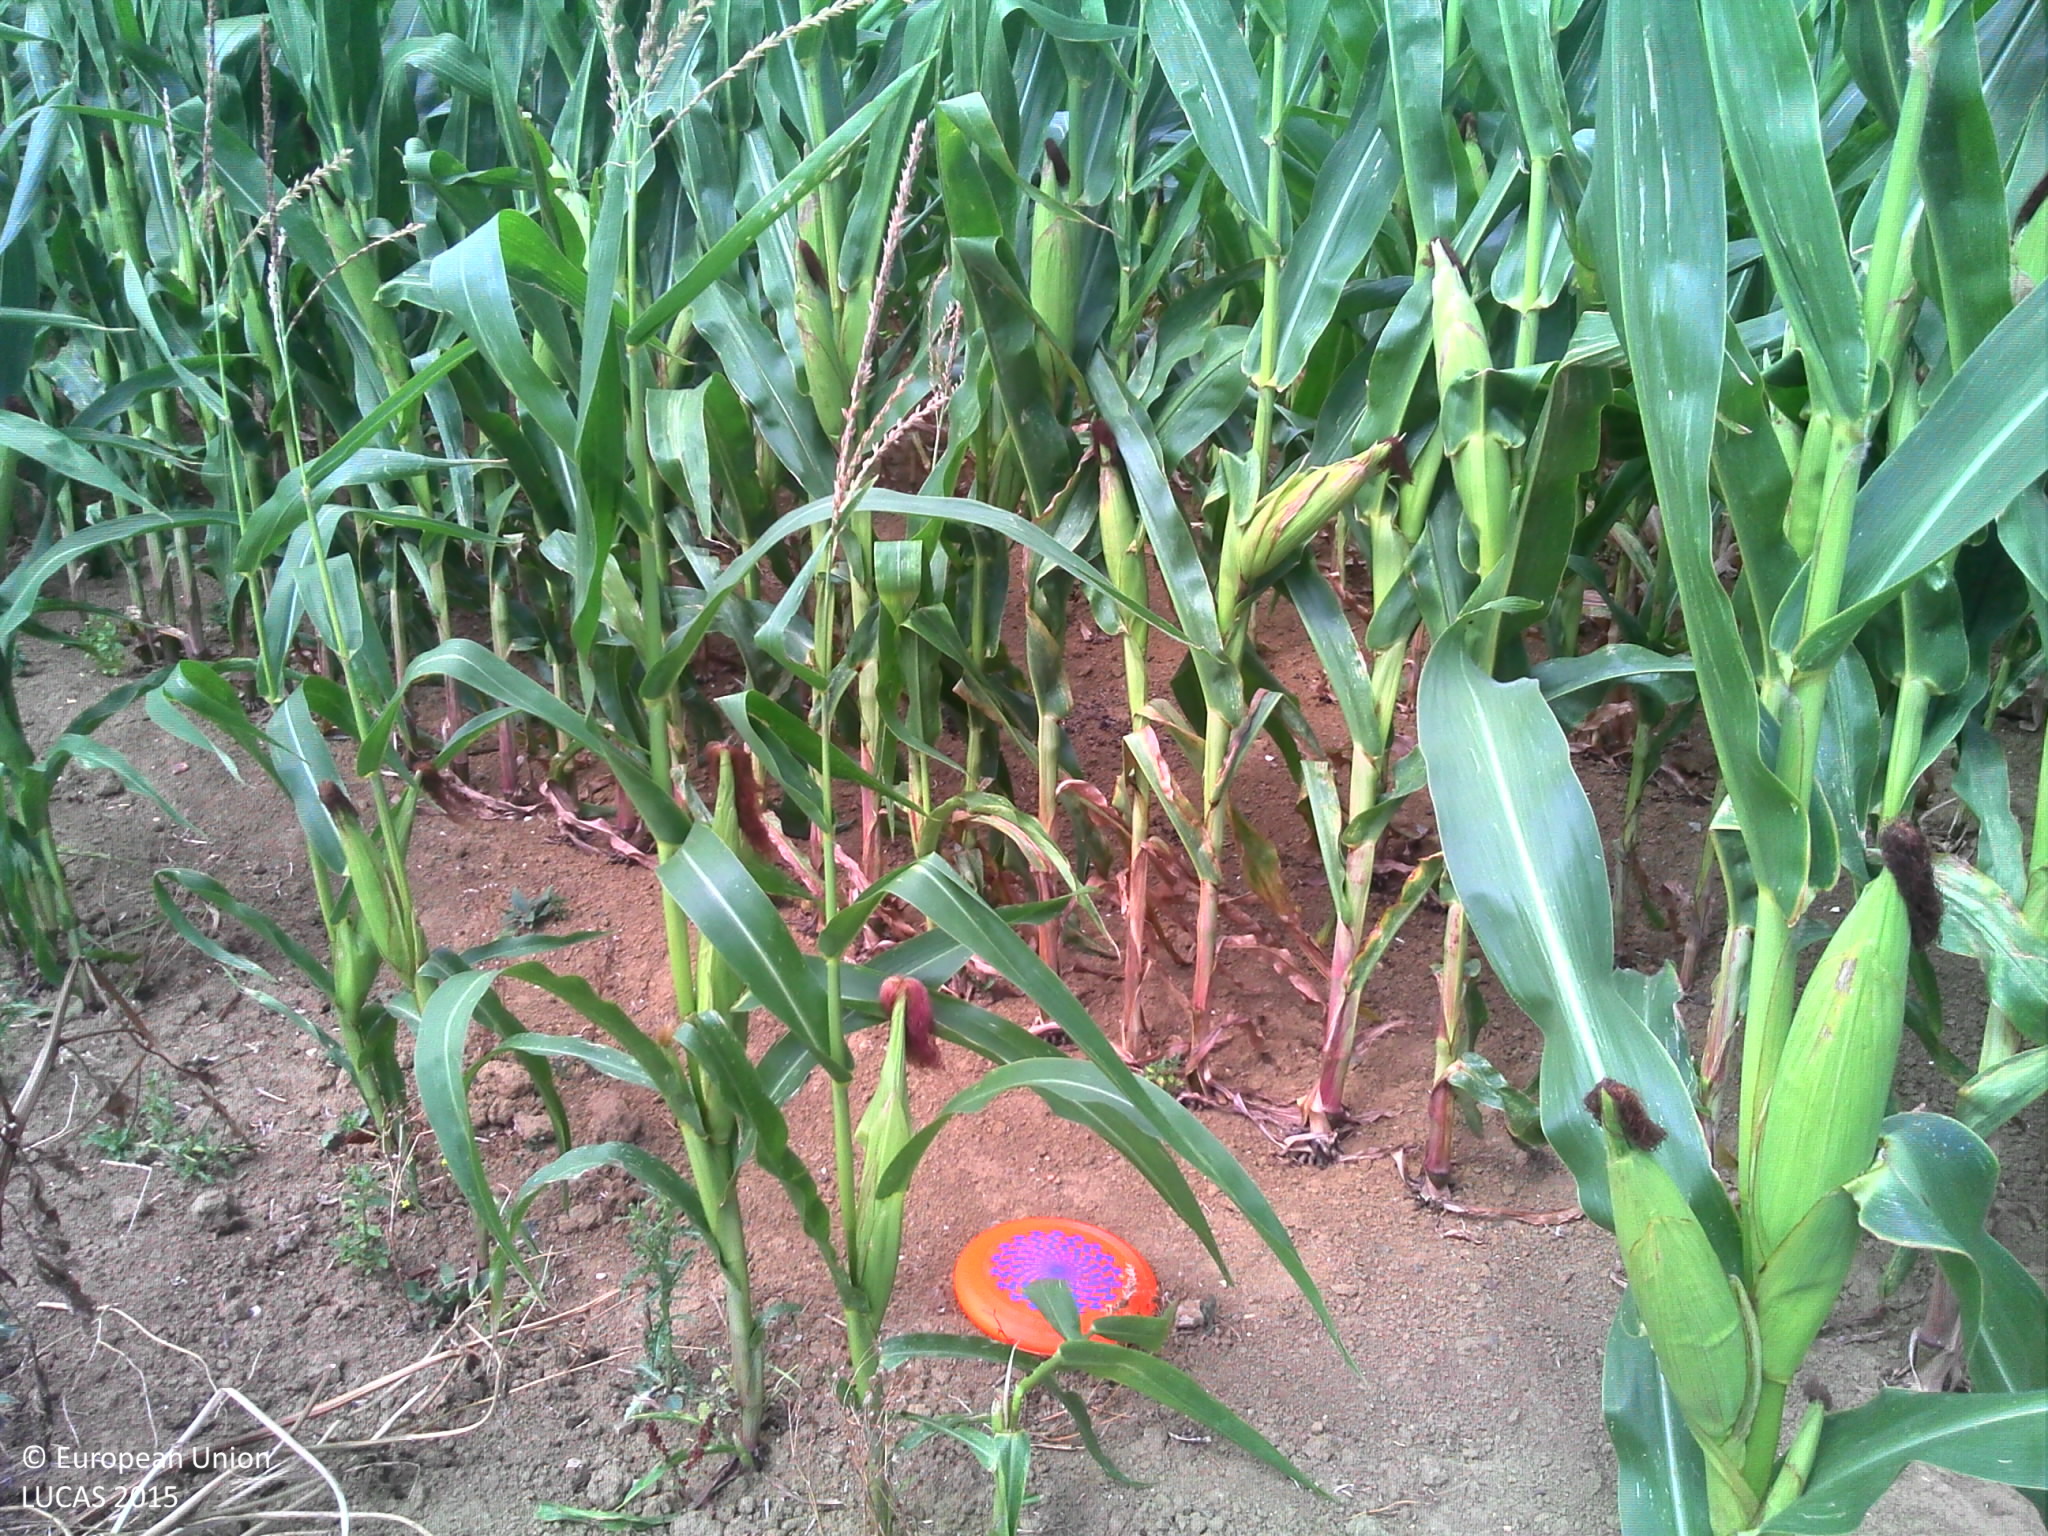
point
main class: Cropland
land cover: Maize
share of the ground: > 75 %
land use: Agriculture (excluding fallow land and kitchen gardens)
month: August
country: FR
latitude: 49.0343
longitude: 2.5065
